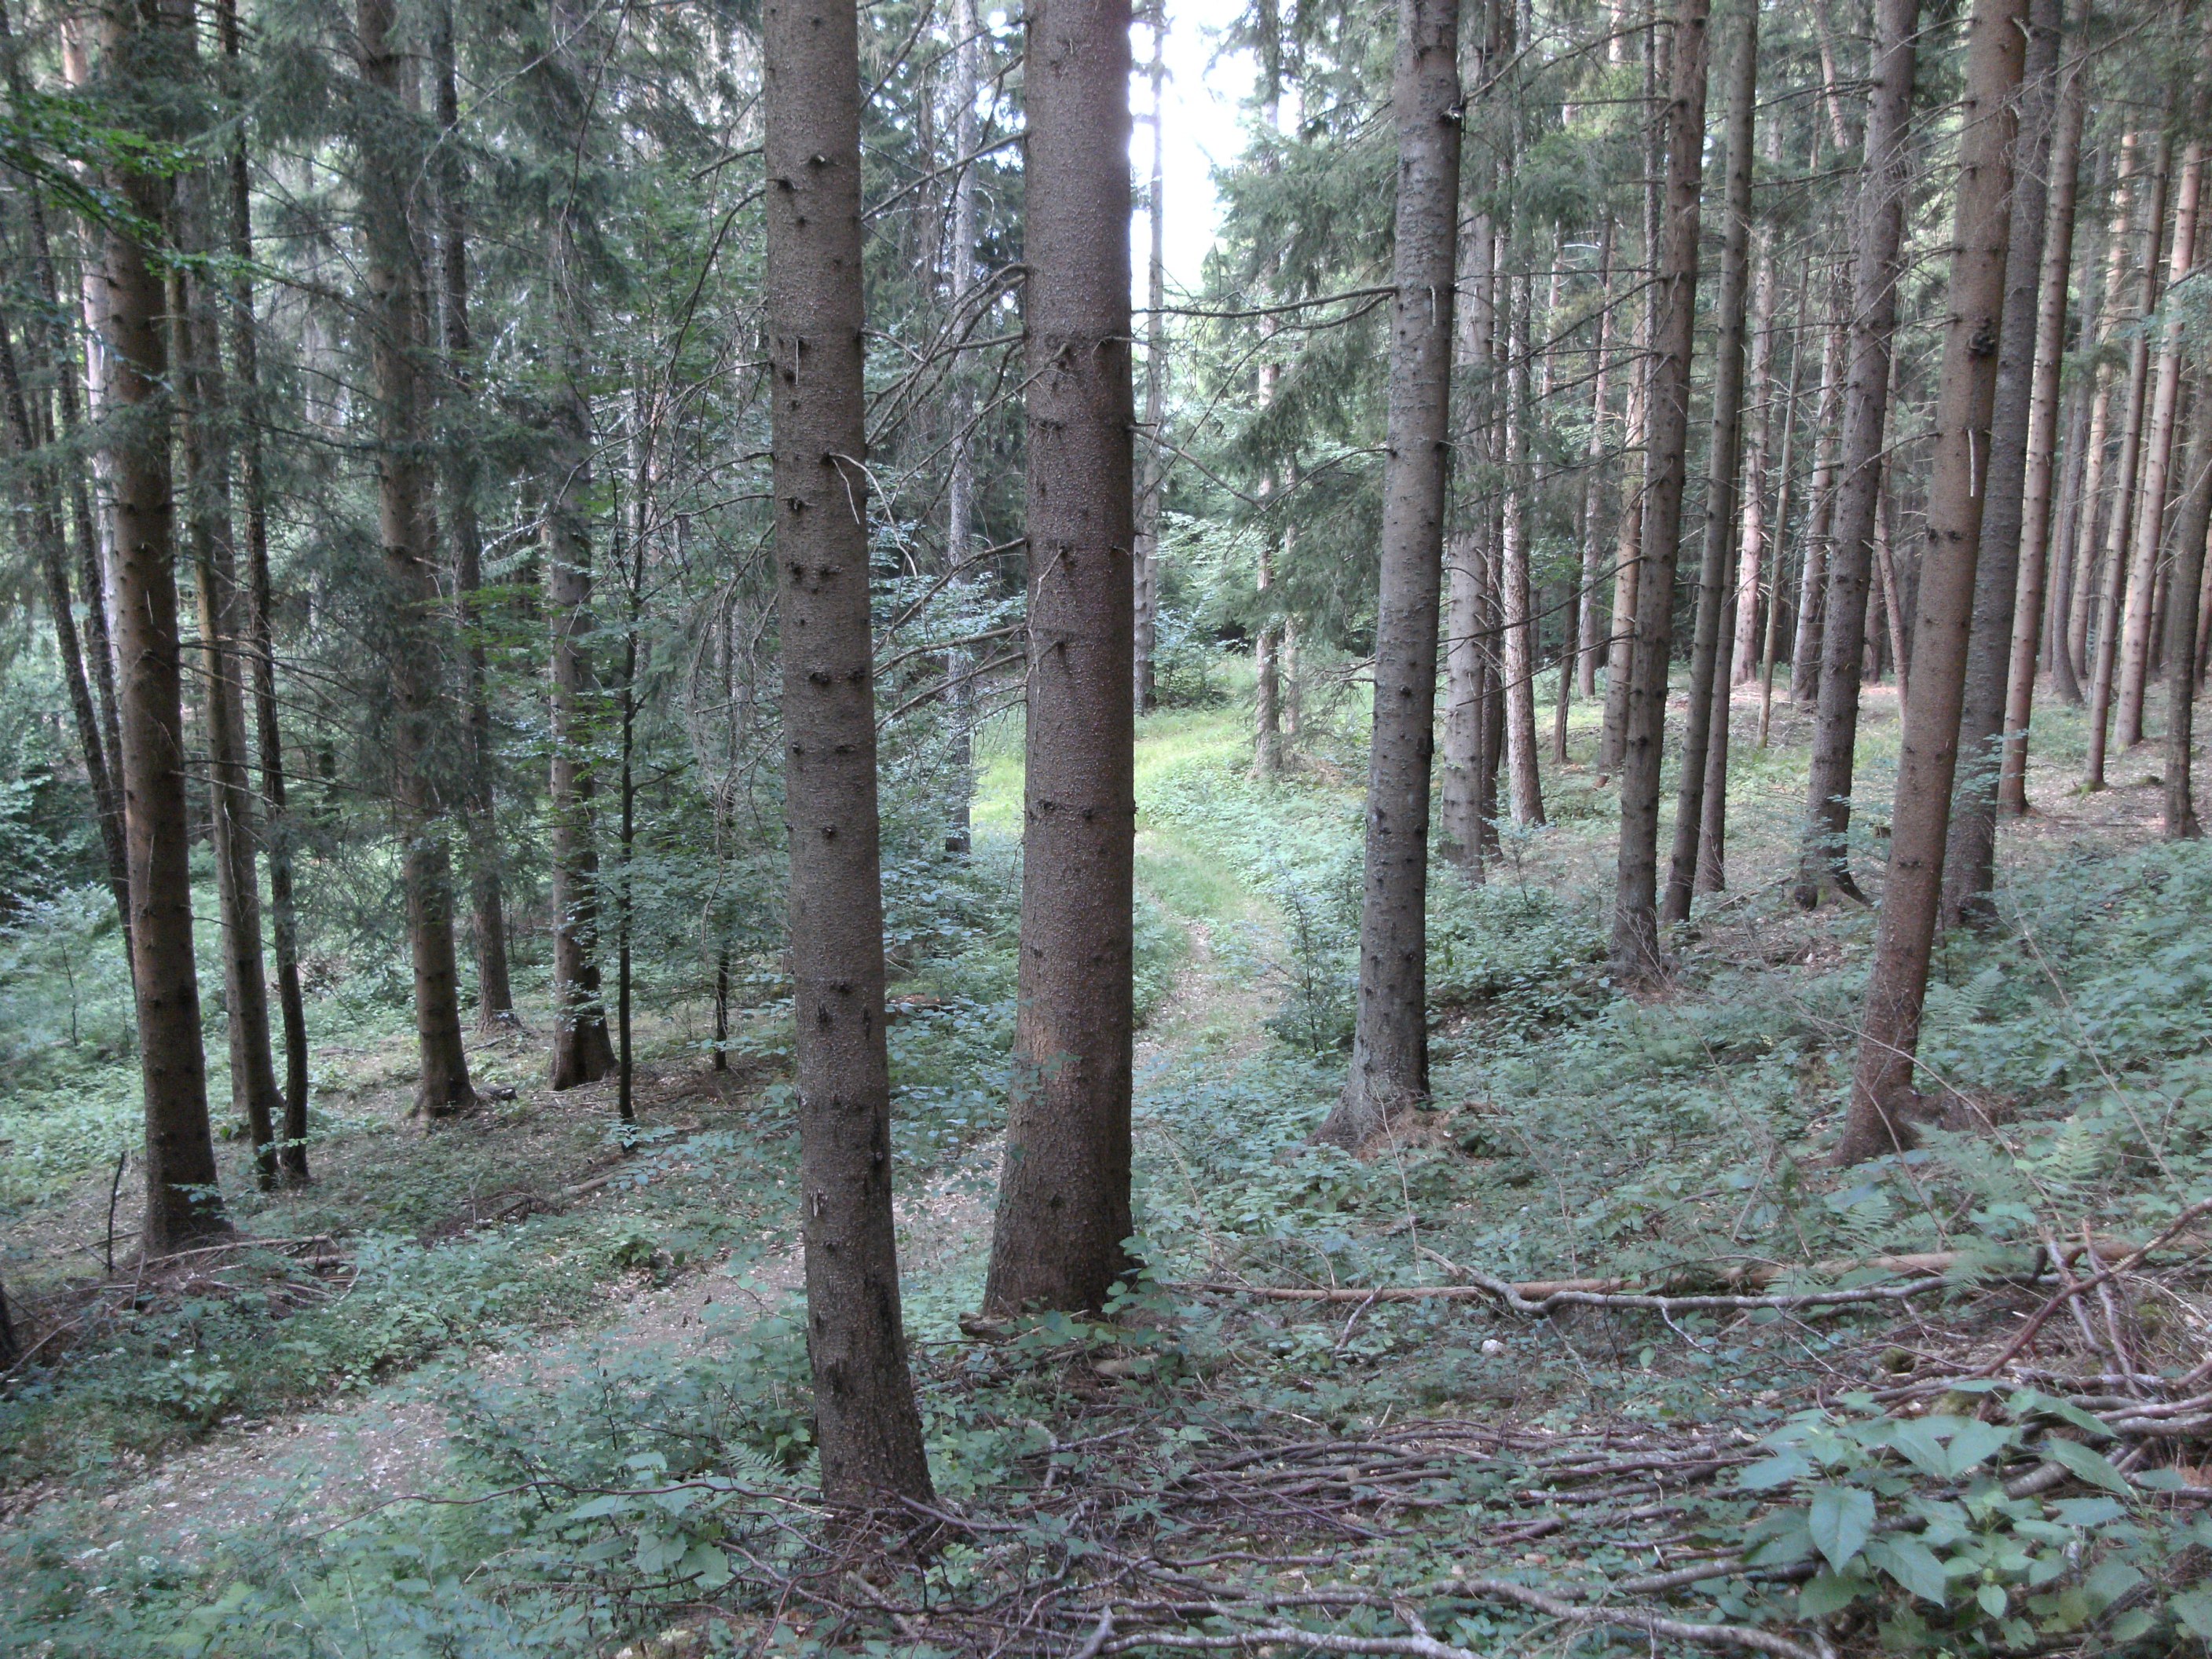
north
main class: Woodland
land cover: Spruce dominated coniferous woodland
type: hemiboreal forest and nemoral coniferous forest and mixed broadleaved-coniferous forest
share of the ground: > 75 %
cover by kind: coniferous forest trees 70 %, broadleaved forest trees 10 %, shrubs 5 %, herbaceous plants 5 %, lichens and mosses 5 %, unconsolidated bare surface 5 %
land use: Forestry
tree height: > 5 m
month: July
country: AT
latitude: 46.5475
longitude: 14.4446
